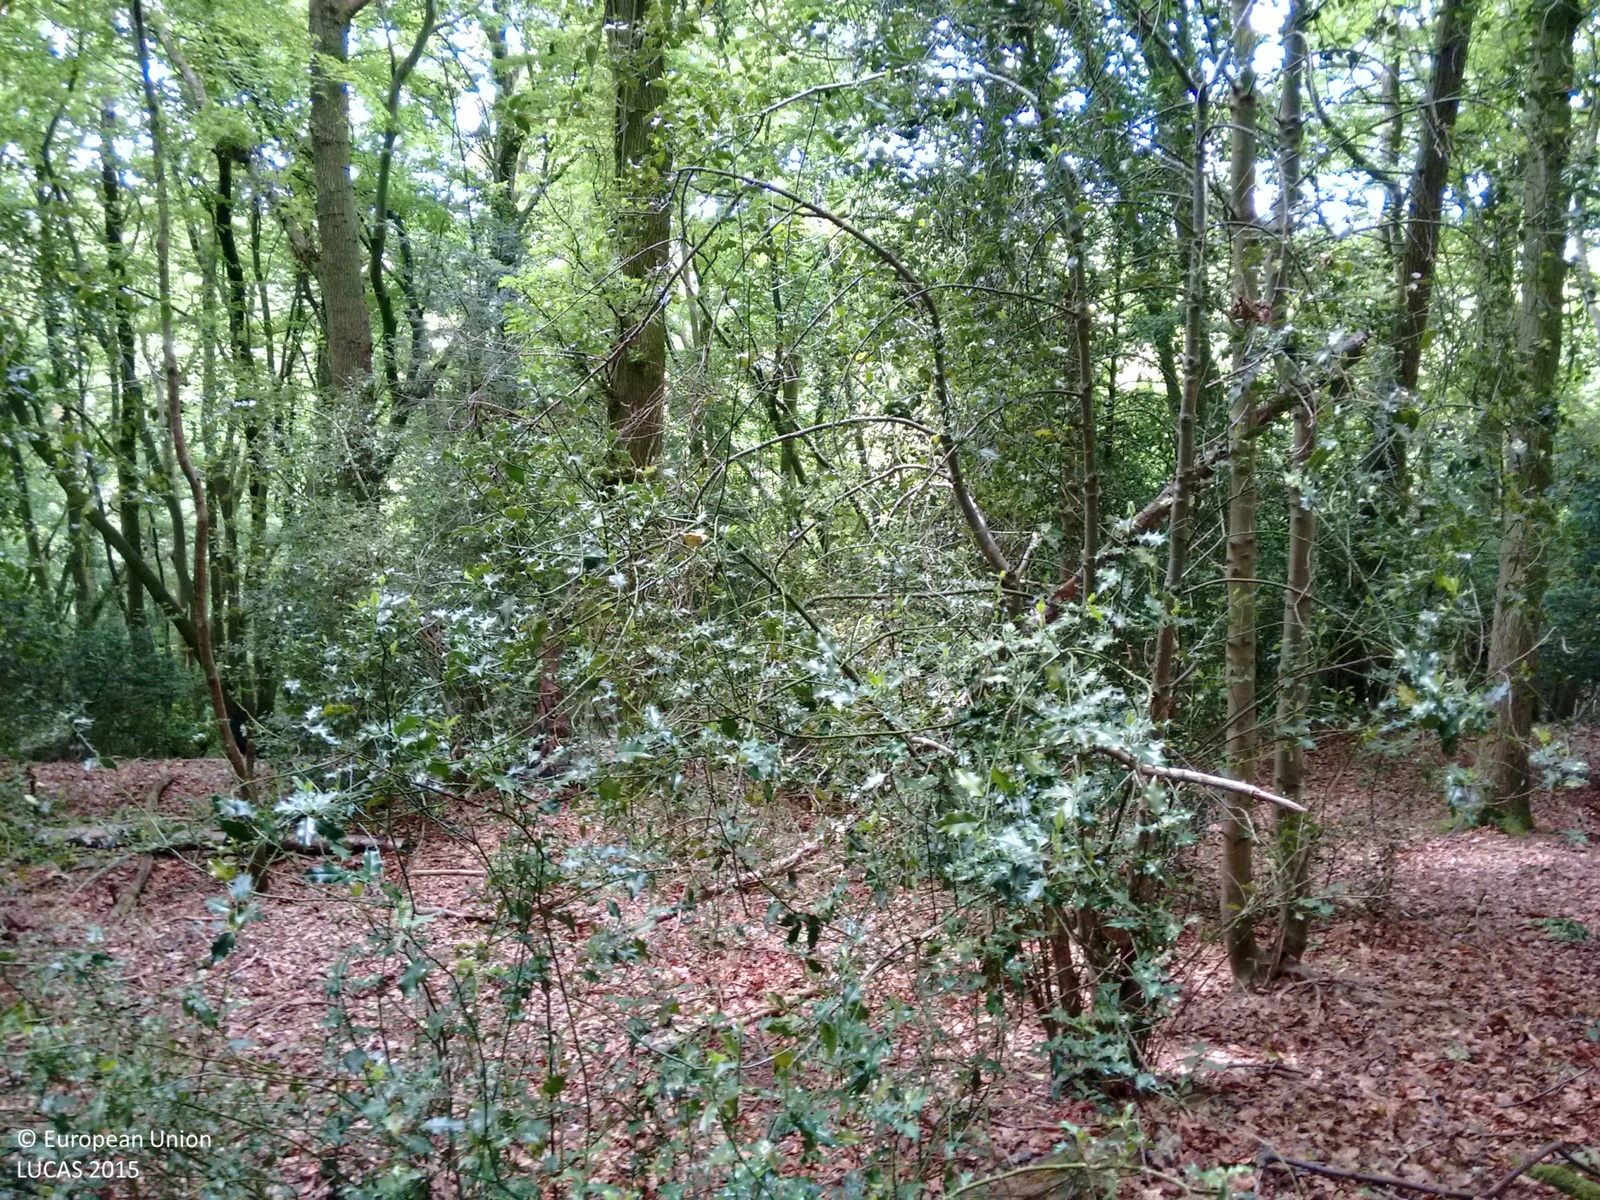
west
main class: Woodland
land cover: Broadleaved woodland
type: mesophytic deciduous forest
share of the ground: > 75 %
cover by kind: broadleaved forest trees 95 %, shrubs 5 %
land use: Semi-natural and natural areas not in use
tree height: > 5 m
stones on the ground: 25 - 50 %
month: June
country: GB
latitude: 51.6873
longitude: -0.7601
